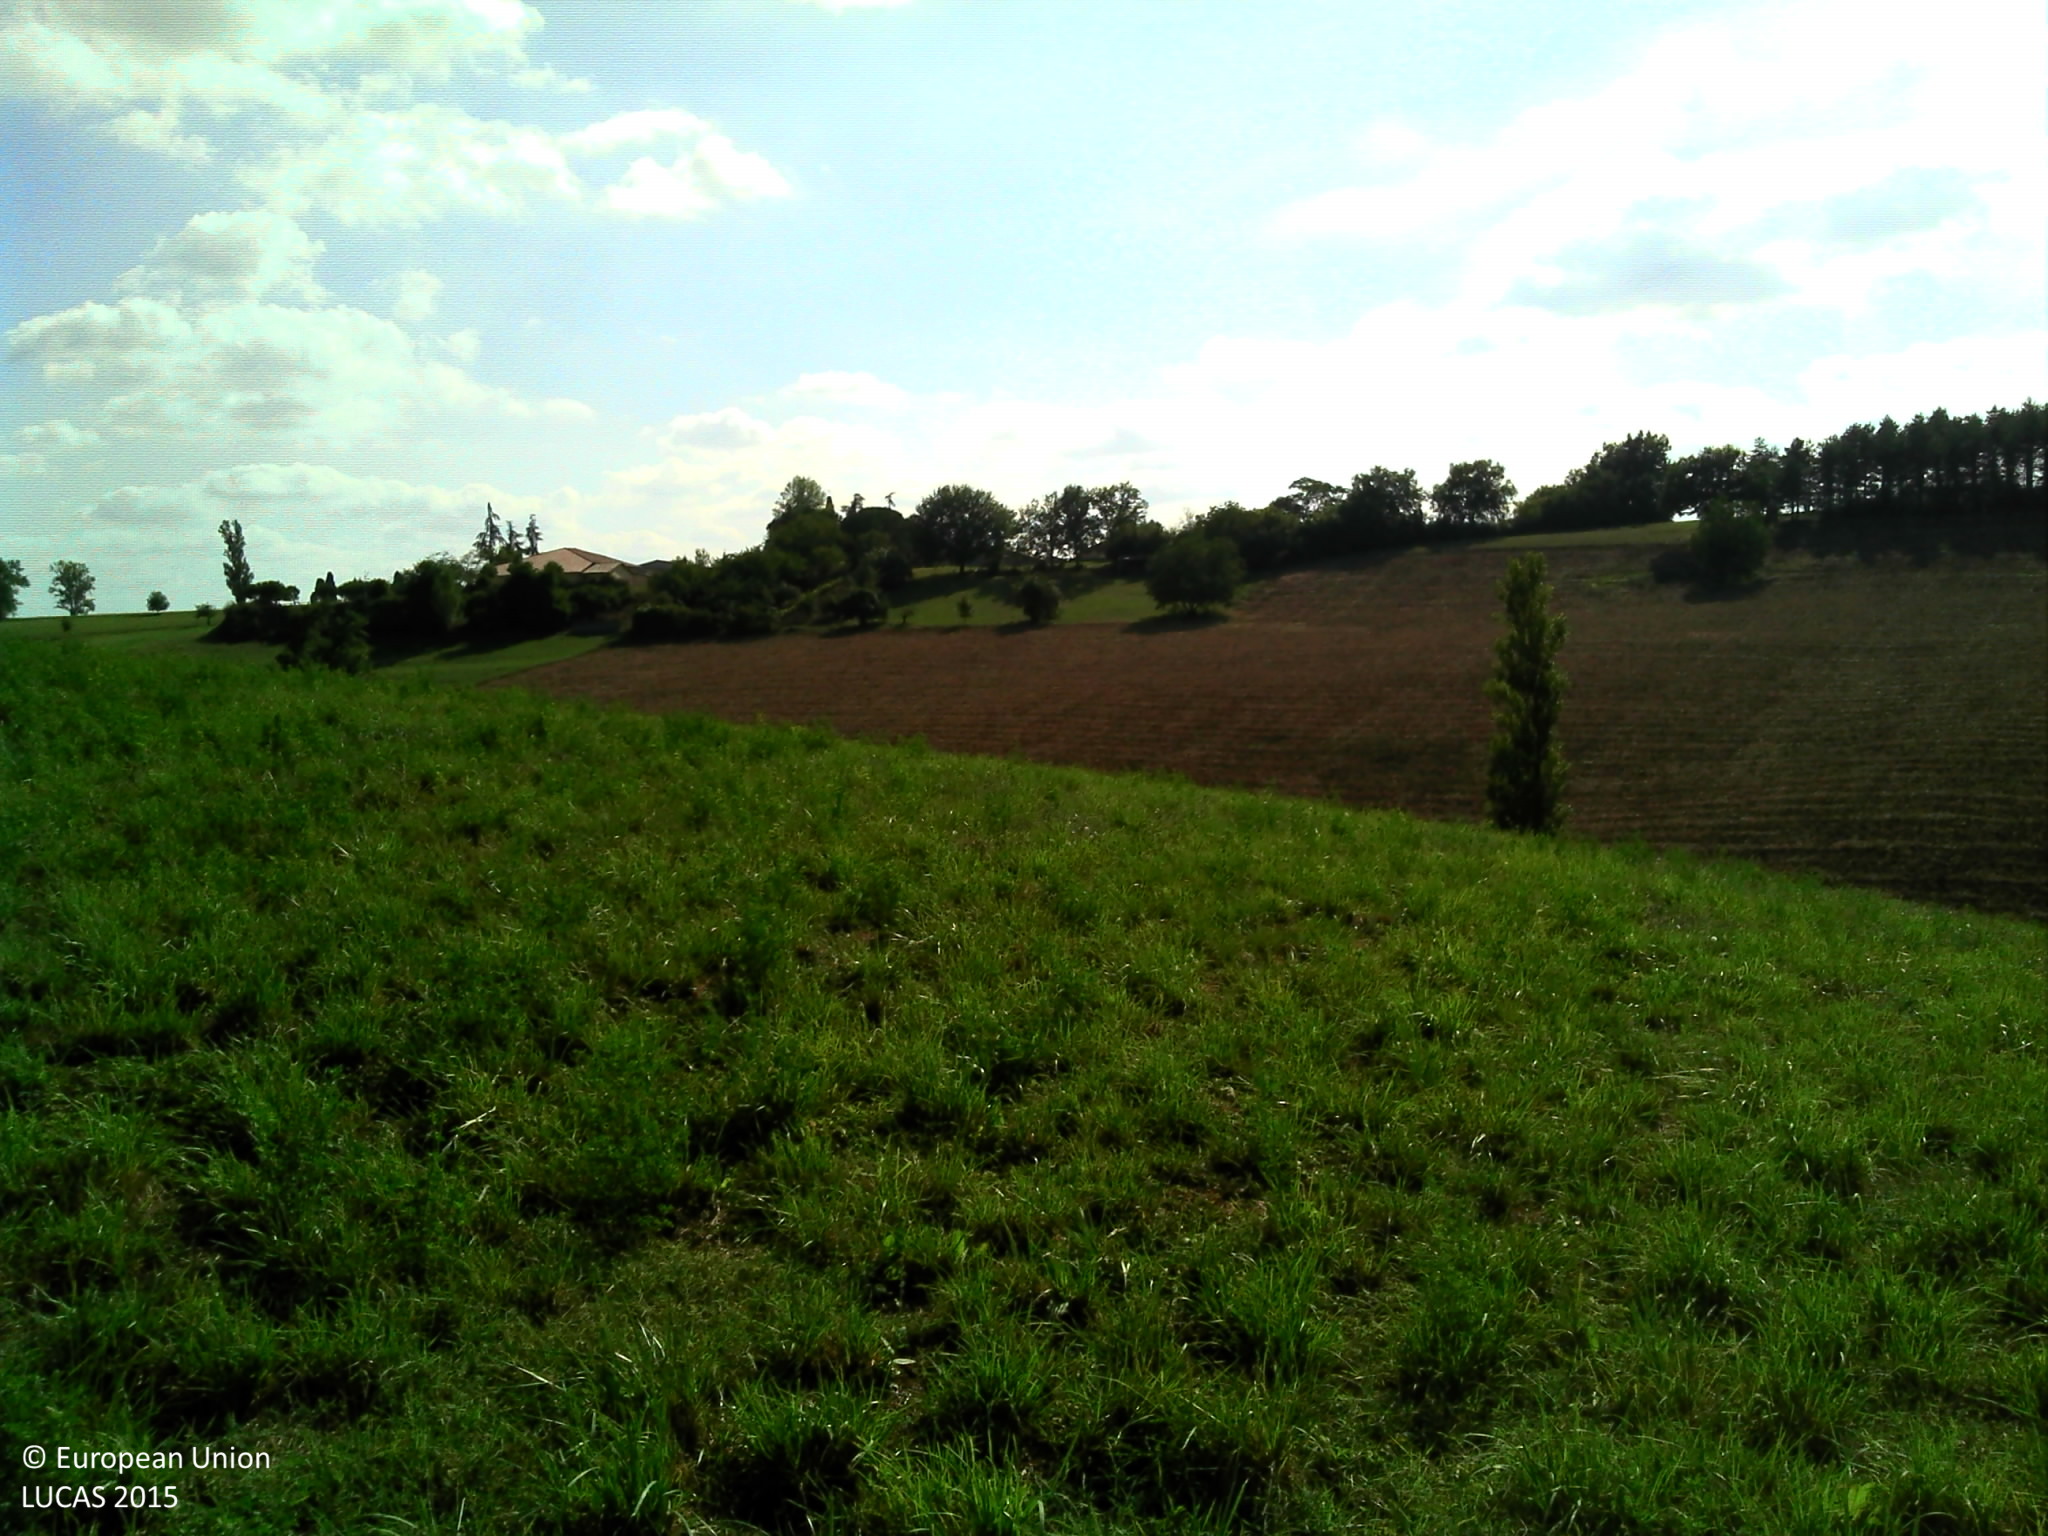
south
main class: Cropland
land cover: Temporary grasslands
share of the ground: > 75 %
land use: Agriculture (excluding fallow land and kitchen gardens)
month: August
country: FR
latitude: 43.9324
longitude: 1.5432
